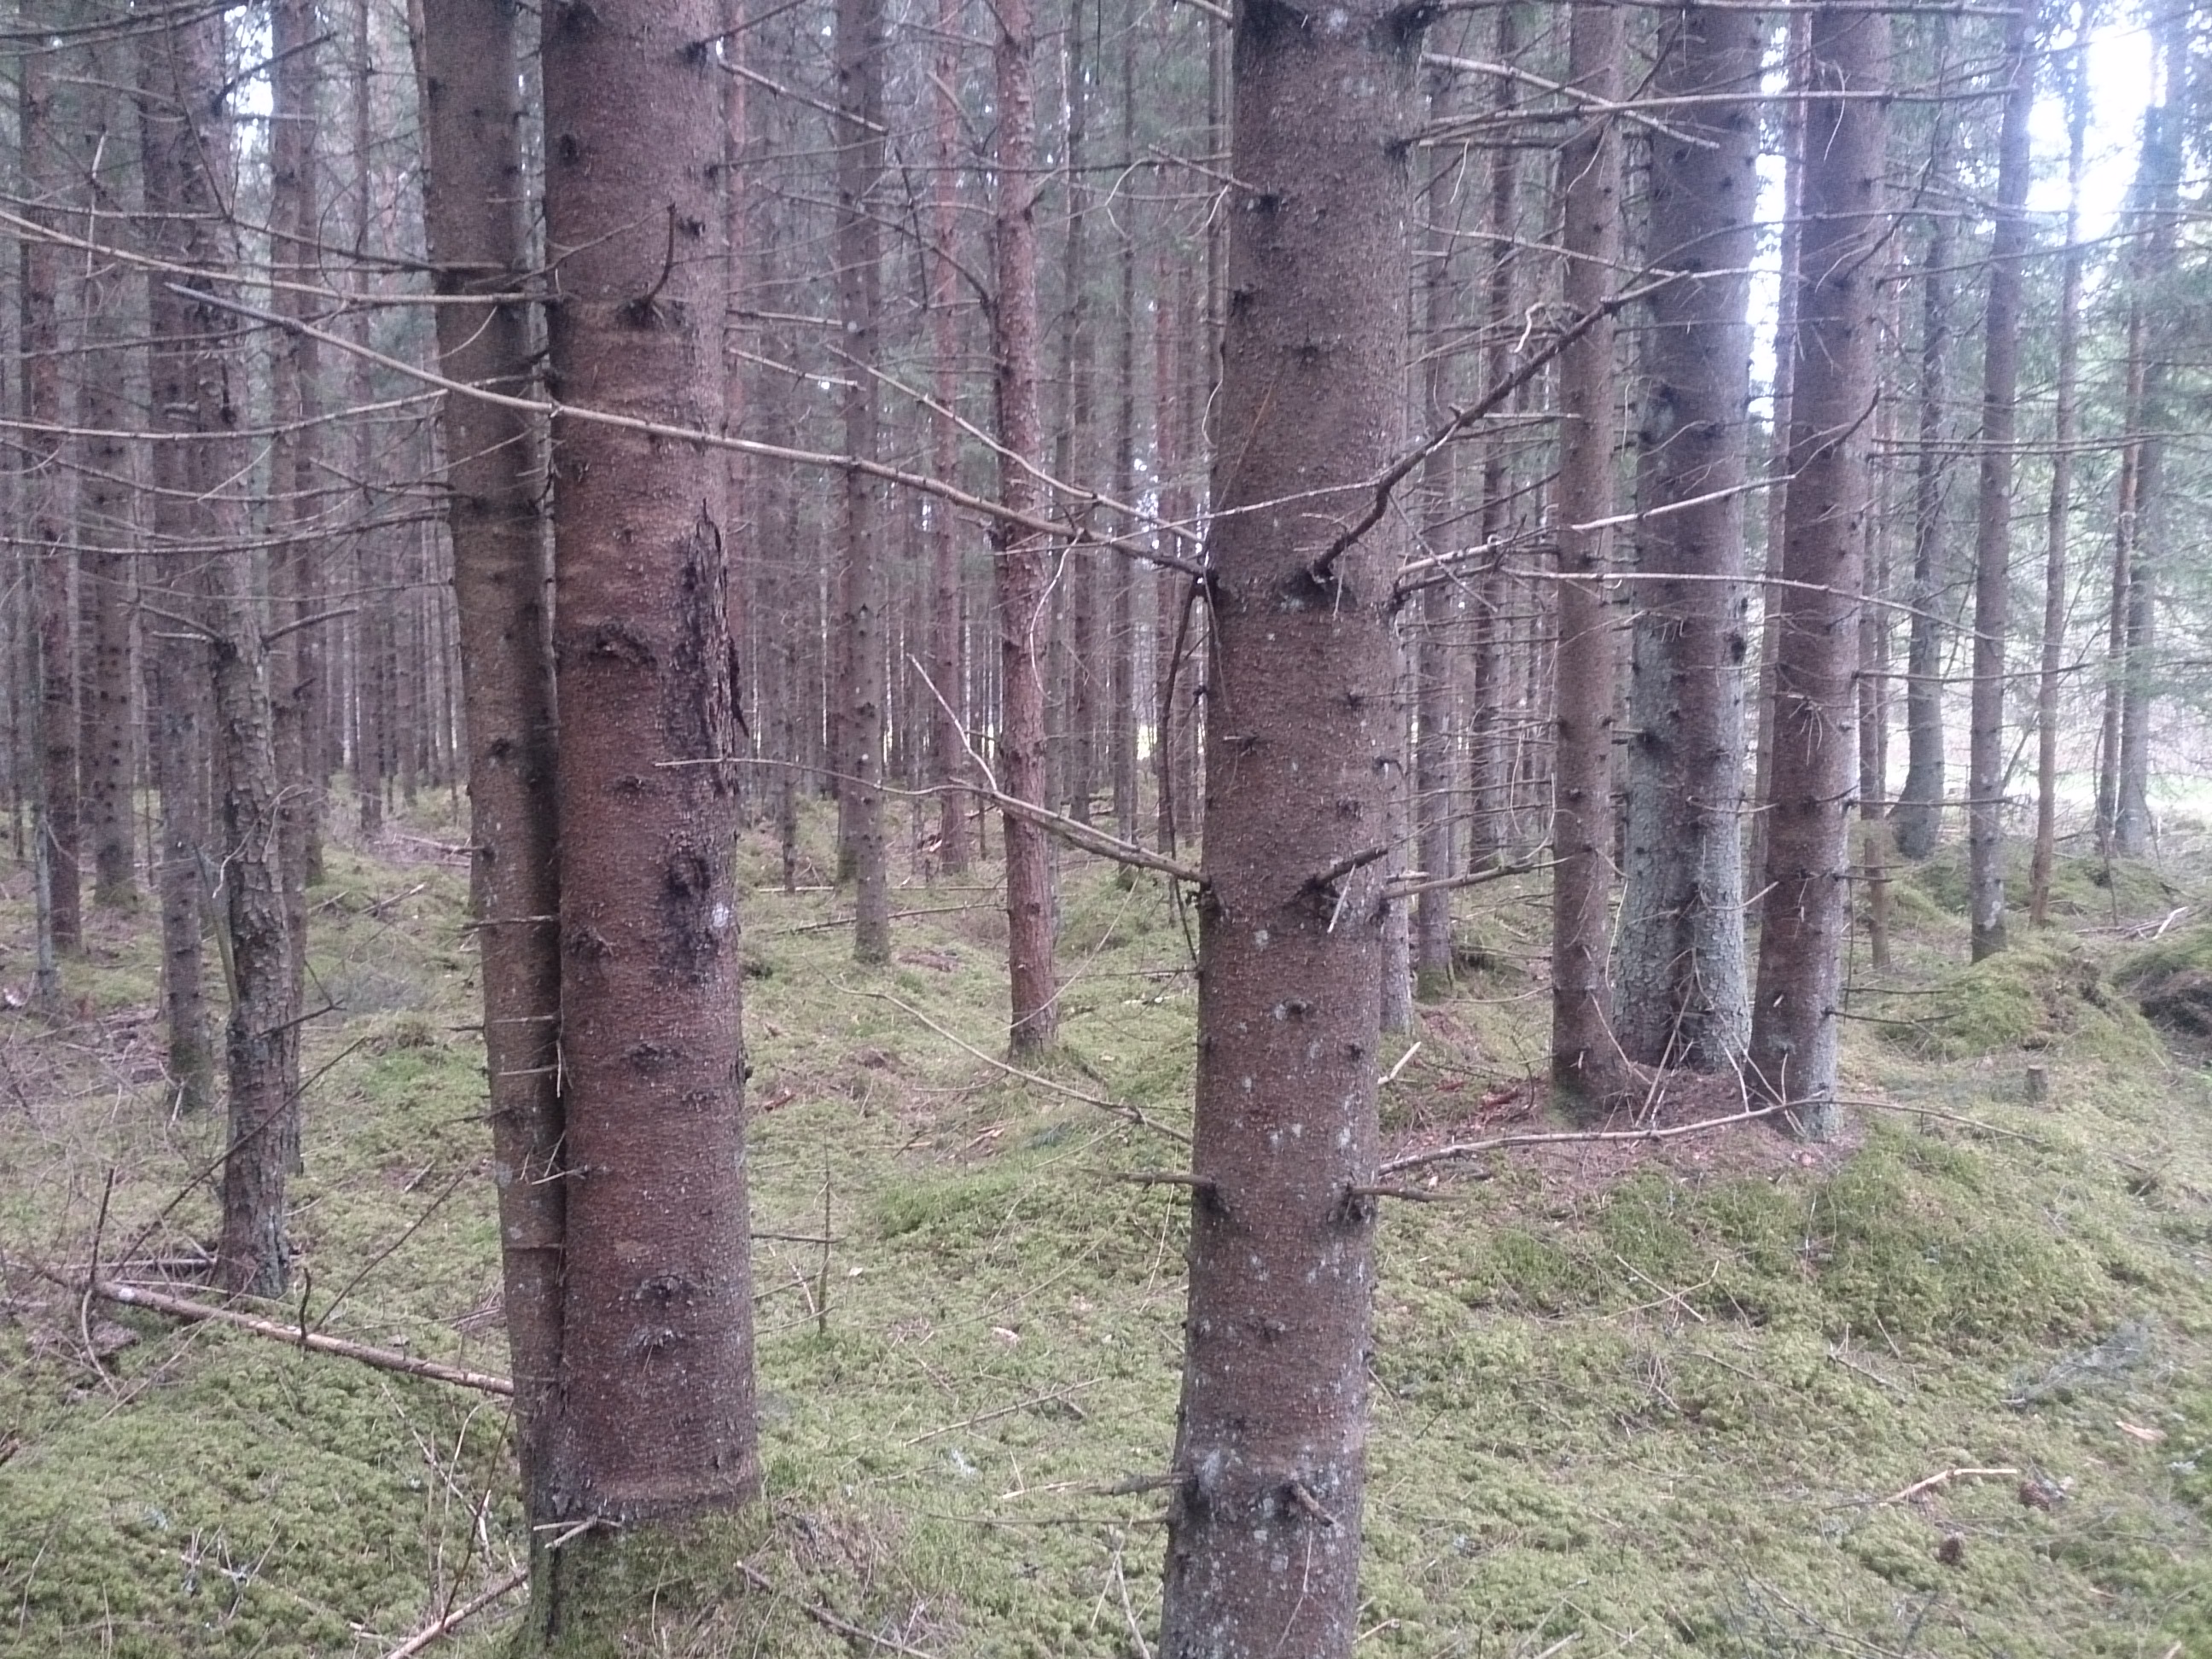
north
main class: Woodland
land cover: Spruce dominated coniferous woodland
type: hemiboreal forest and nemoral coniferous forest and mixed broadleaved-coniferous forest
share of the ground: > 75 %
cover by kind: coniferous forest trees 100 %
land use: Forestry
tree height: > 5 m
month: May
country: LV
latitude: 56.7041
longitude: 24.0835
